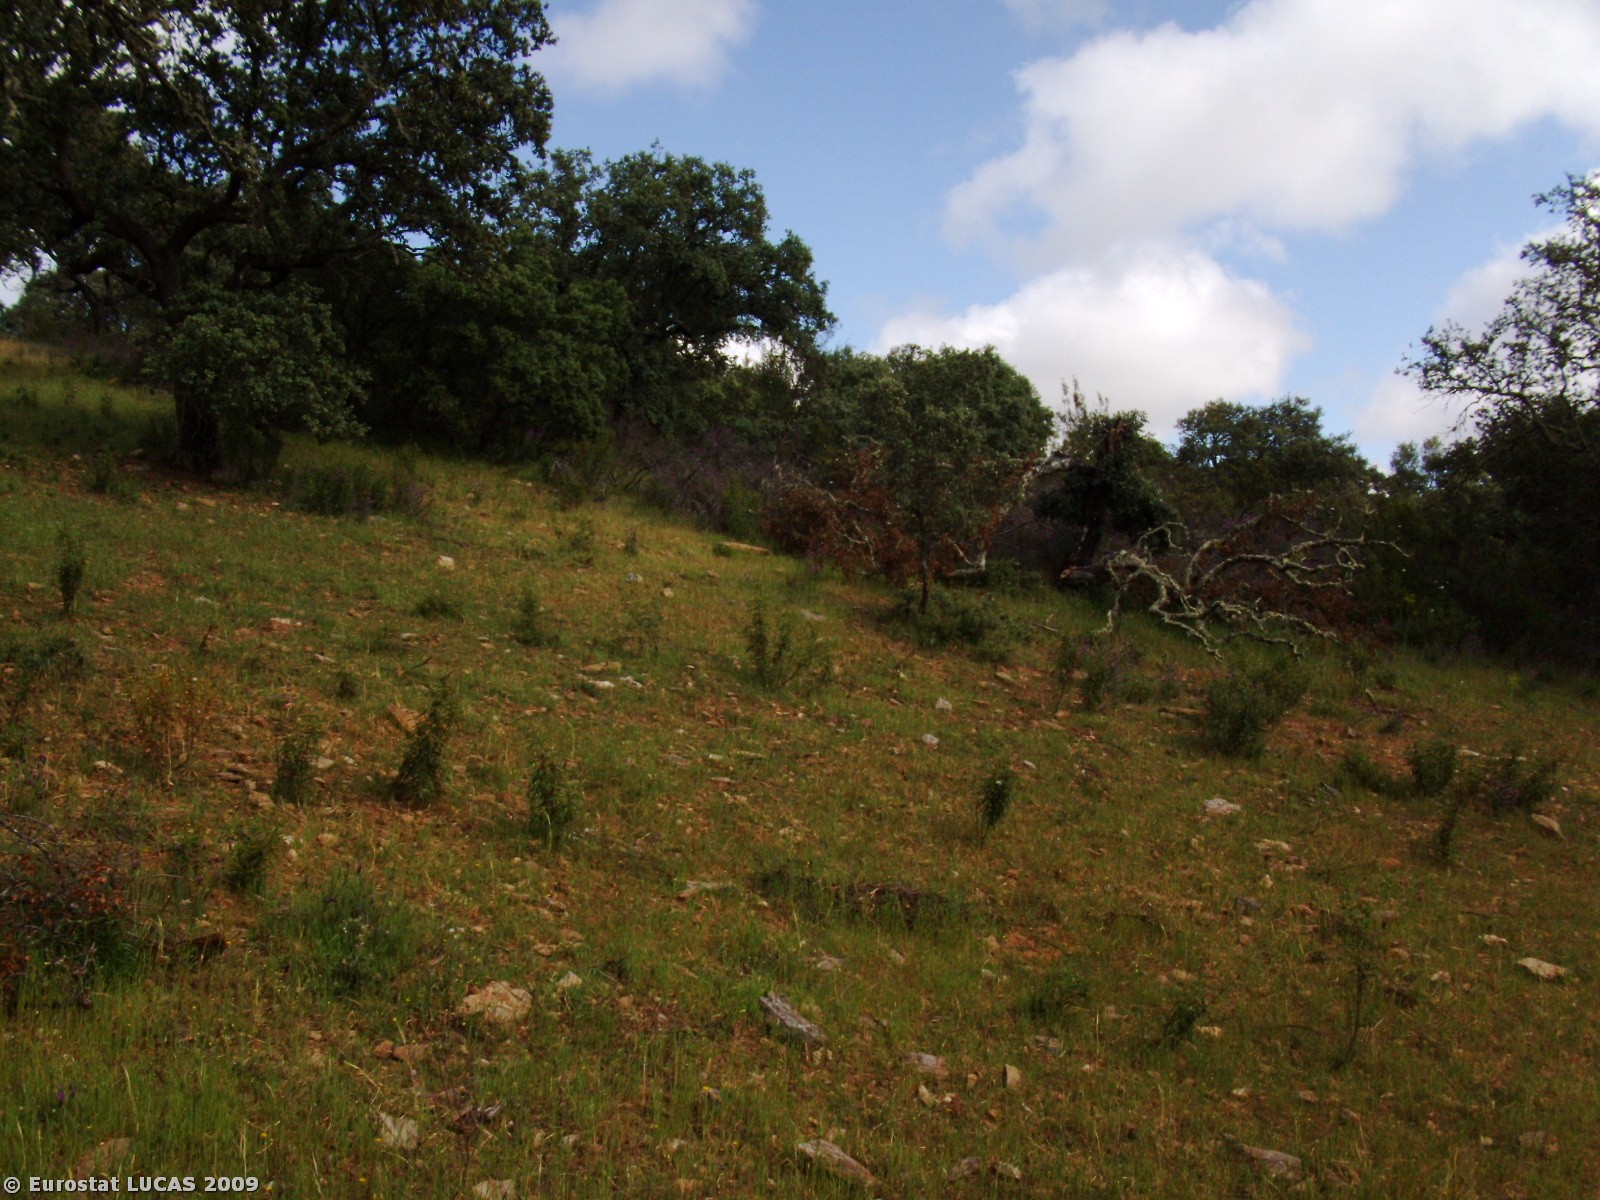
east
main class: Woodland
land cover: Broadleaved woodland
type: broadleaved evergreen forest
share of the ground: 25 - 50 %
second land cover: Spontaneously vegetated surfaces
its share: 50 - 75 %
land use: Forestry
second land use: Fallow land
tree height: > 5 m
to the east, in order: Broadleaved woodland; Spontaneously vegetated surfaces; Tracks; Fences; Broadleaved woodland
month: April
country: PT
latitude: 38.5171
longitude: -7.6841
